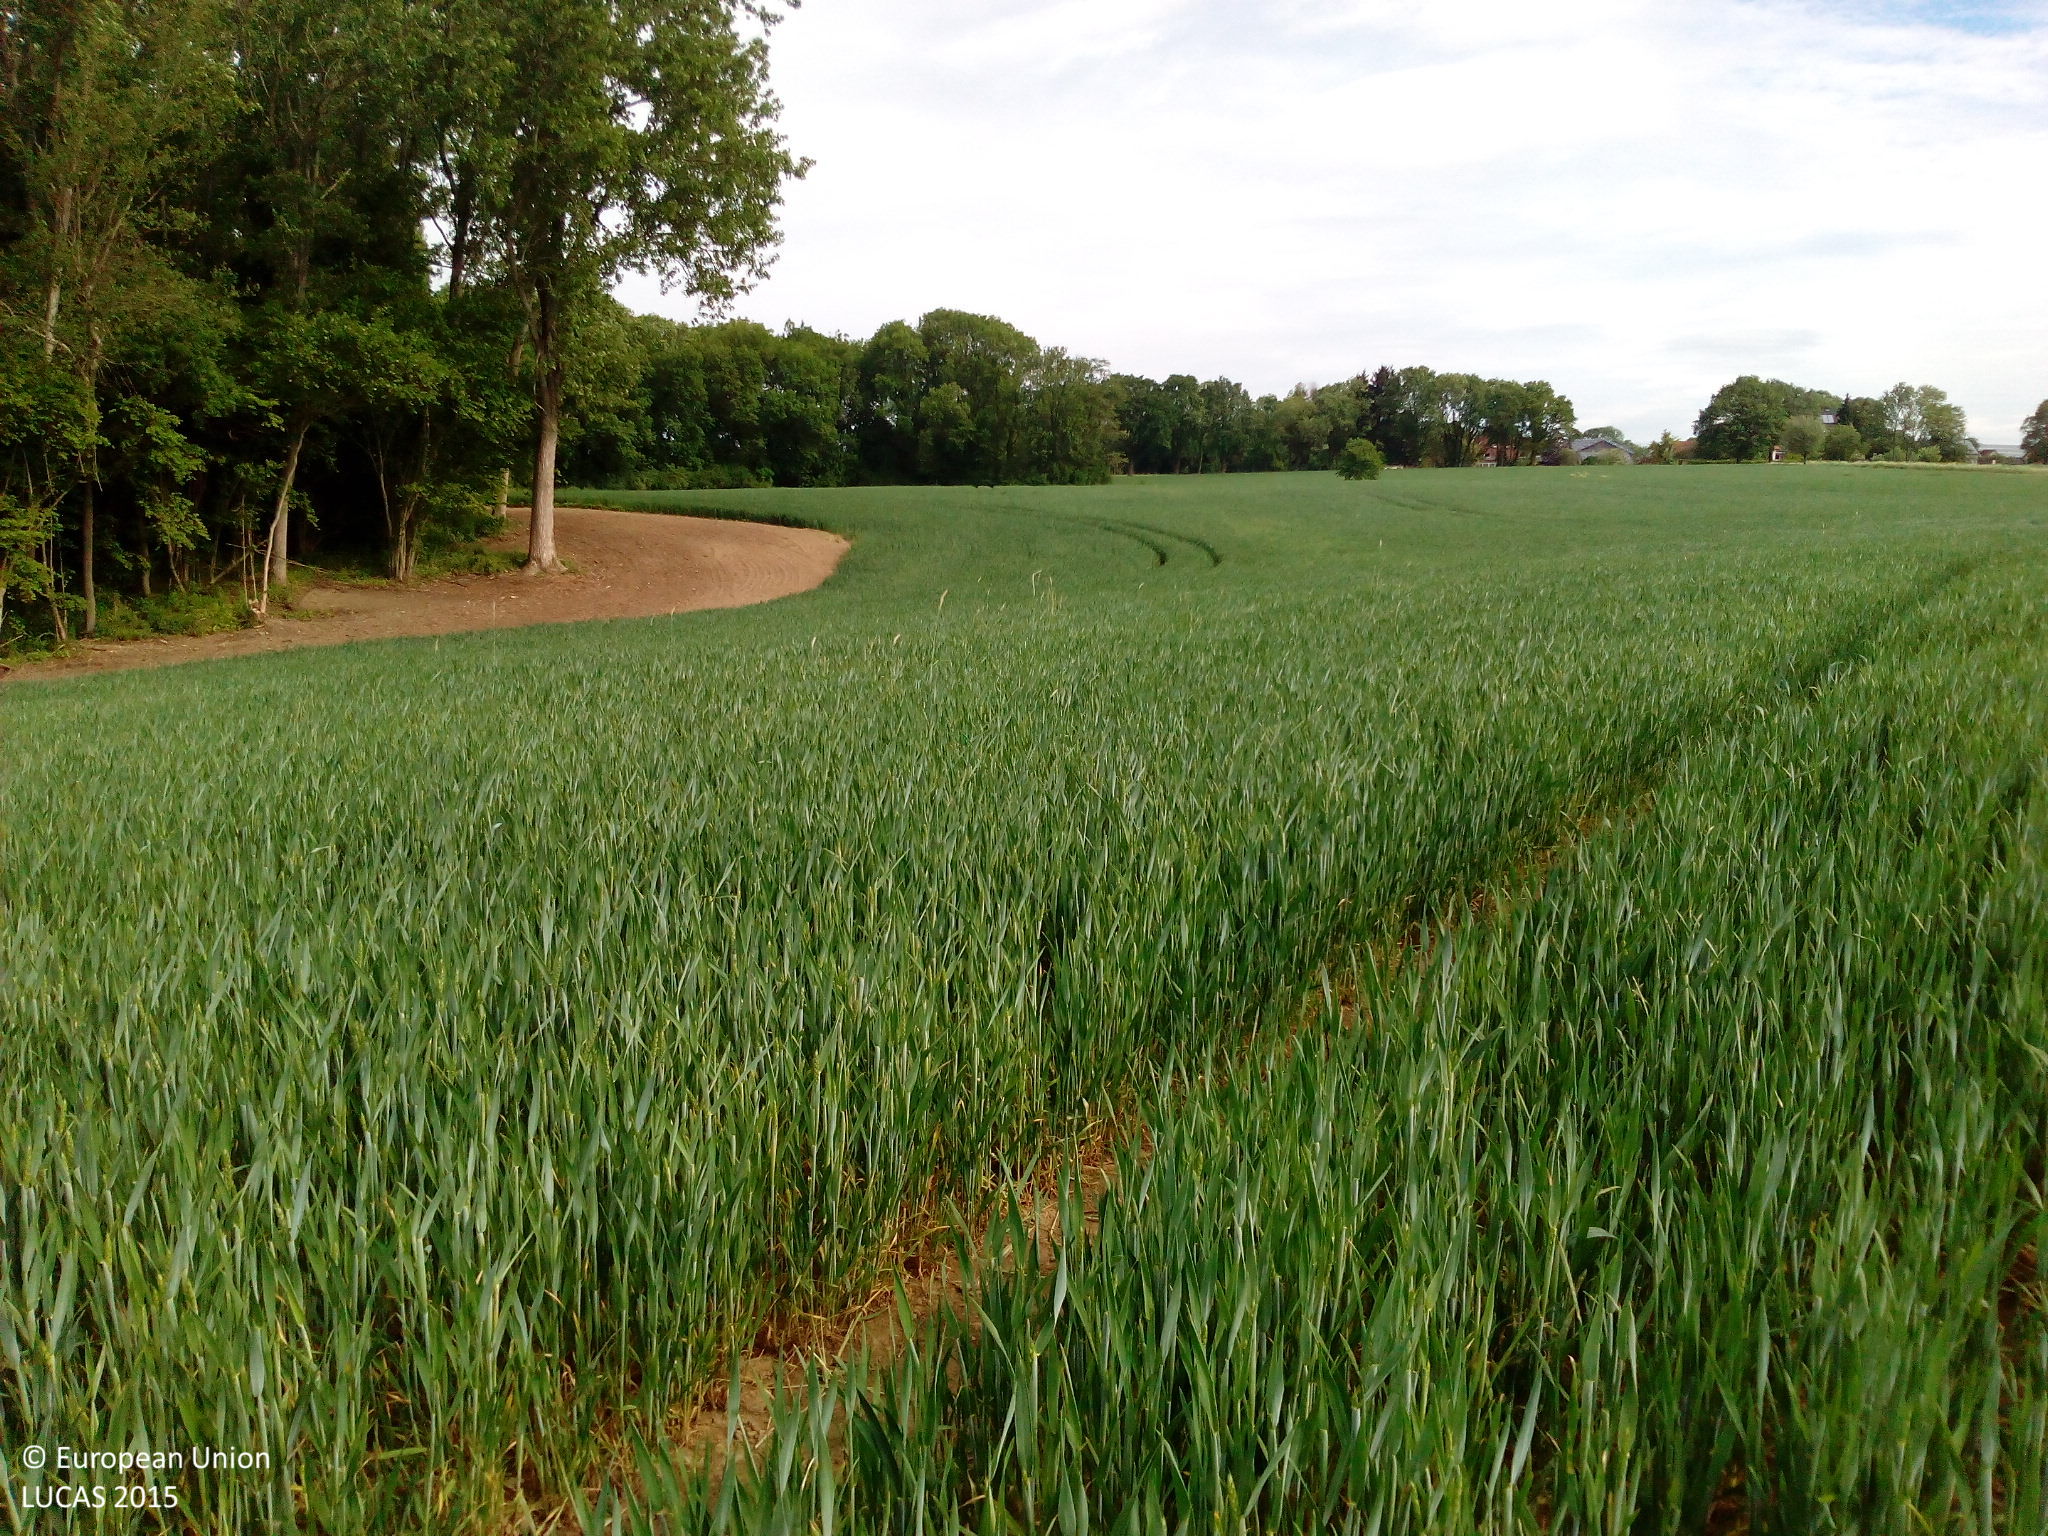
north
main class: Cropland
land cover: Common wheat
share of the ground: > 75 %
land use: Agriculture (excluding fallow land and kitchen gardens)
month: June
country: DE
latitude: 51.5340
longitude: 8.0253
